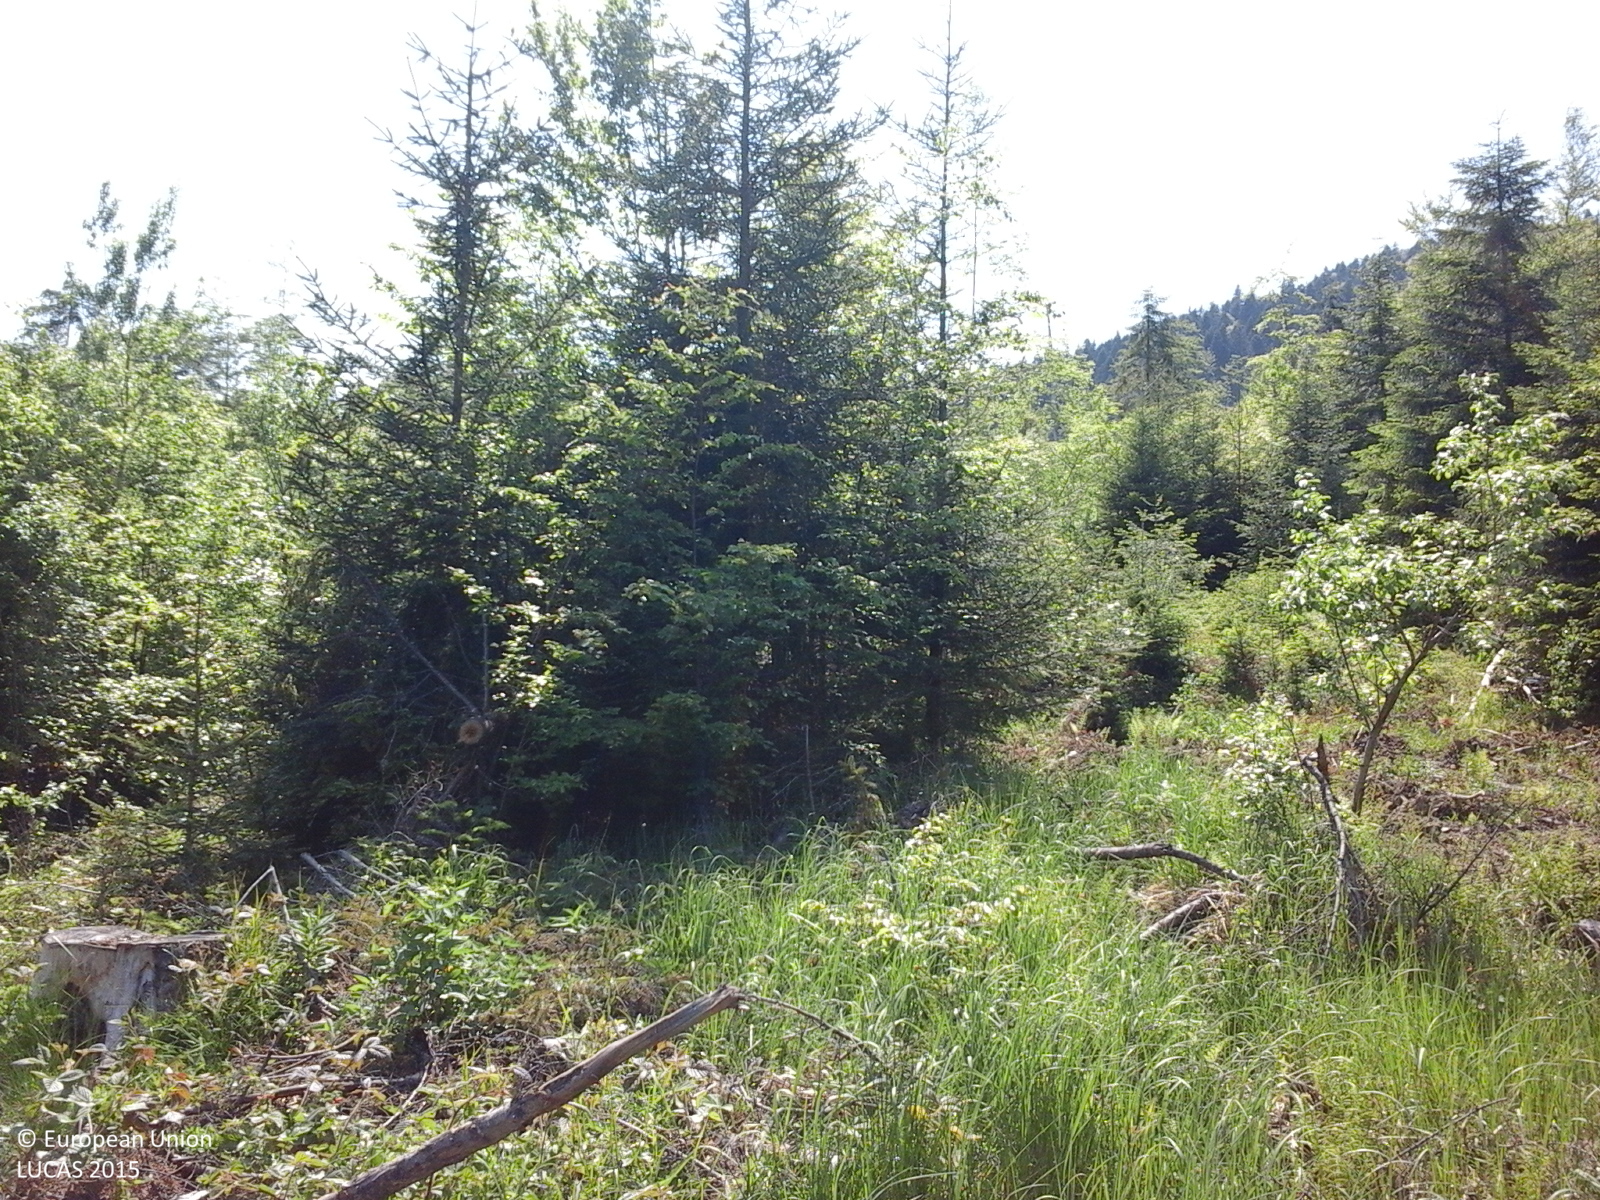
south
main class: Shrubland
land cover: Shrubland with sparse tree cover
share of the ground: > 75 %
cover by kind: shrubs 75 %, herbaceous plants 20 %, broadleaved forest trees 5 %
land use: Forestry
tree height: < 5 m
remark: Clear cut
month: May
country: RO
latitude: 45.6094
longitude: 26.5009
